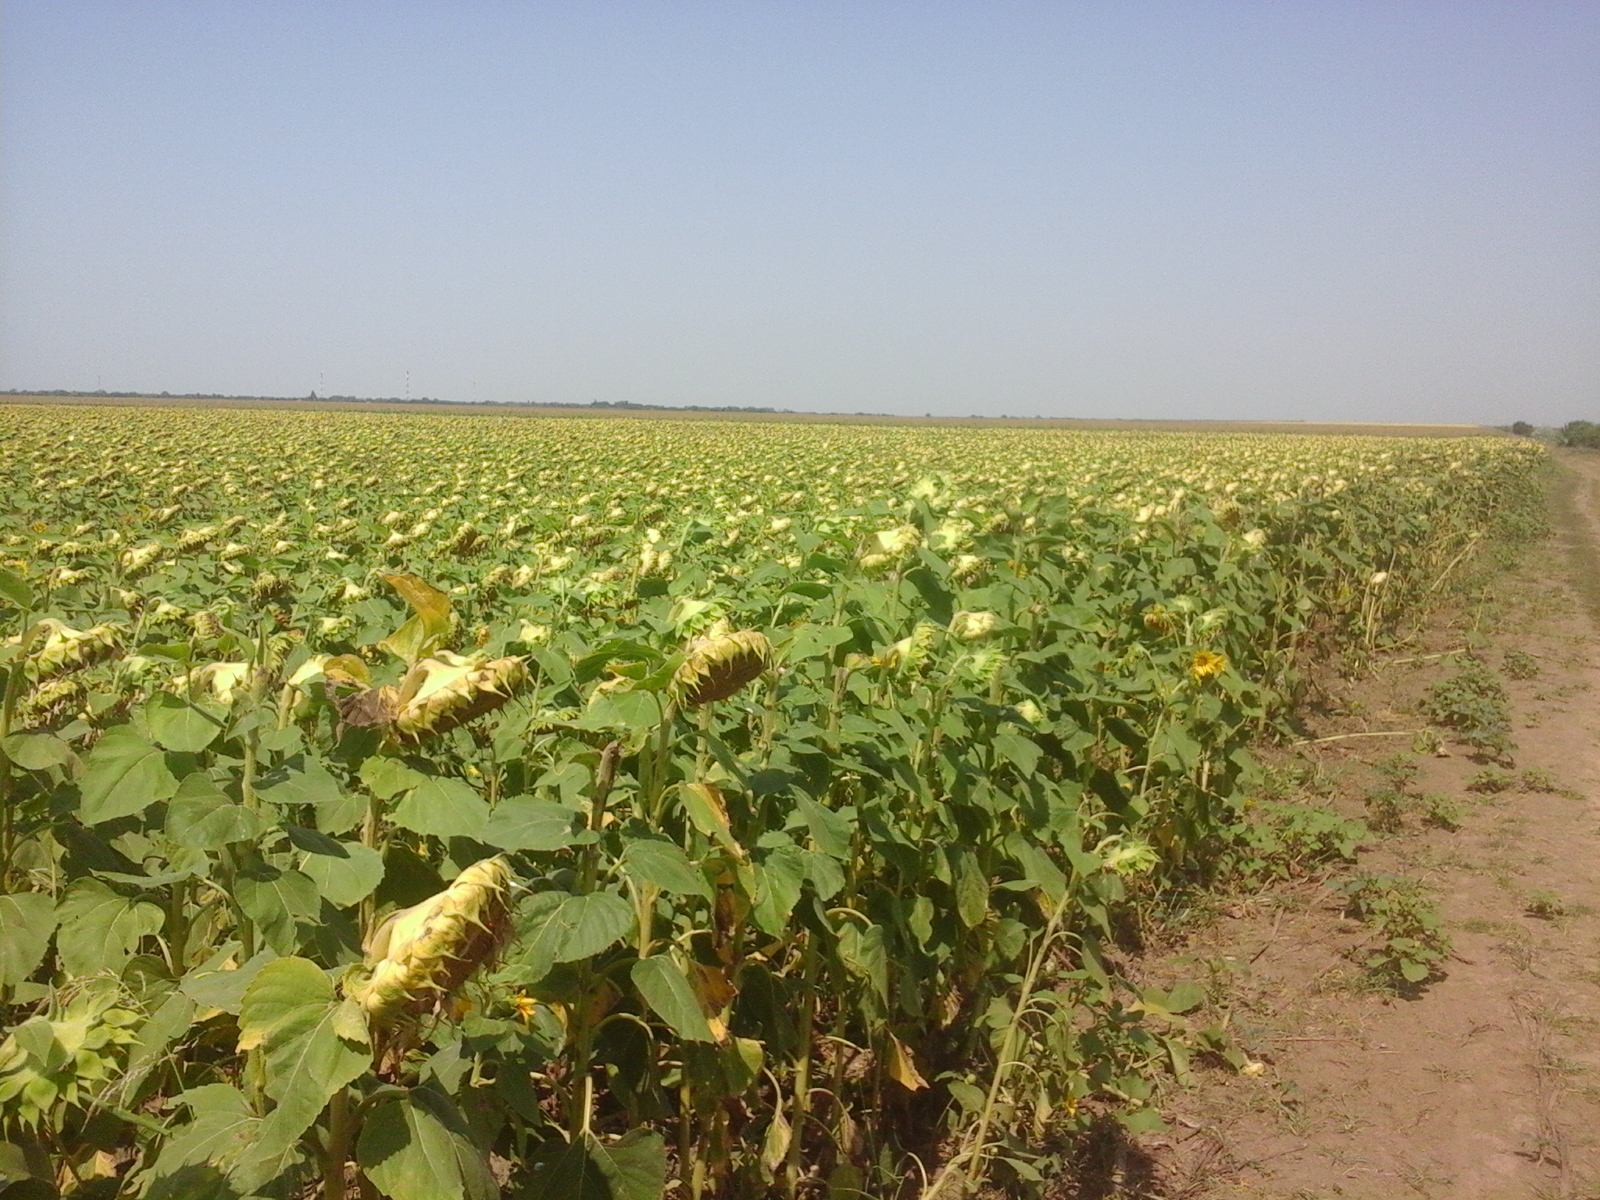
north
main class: Cropland
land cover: Sunflower
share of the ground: > 75 %
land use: Agriculture (excluding fallow land and kitchen gardens)
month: August
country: RO
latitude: 45.0159
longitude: 27.7564
